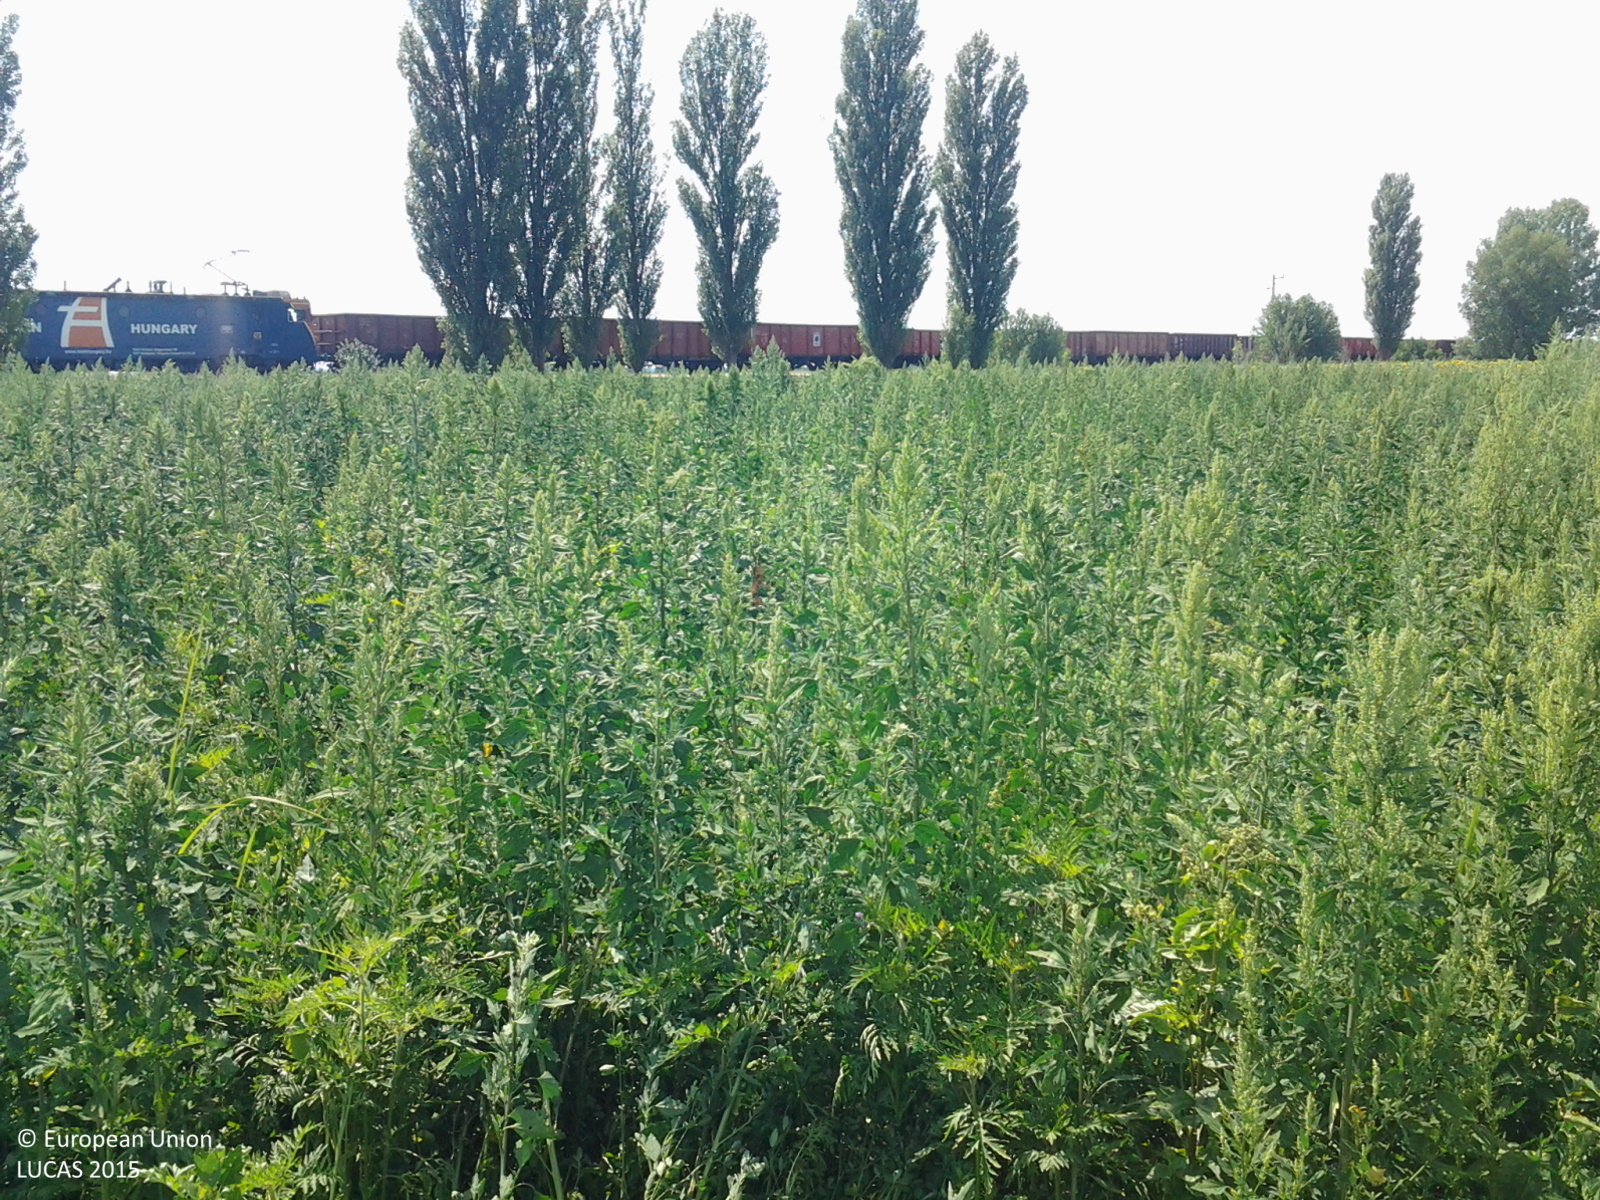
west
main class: Cropland
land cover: Lucerne
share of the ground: > 75 %
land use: Agriculture (excluding fallow land and kitchen gardens)
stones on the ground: < 10 %
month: July
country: HU
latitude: 47.5487
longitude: 19.8173
